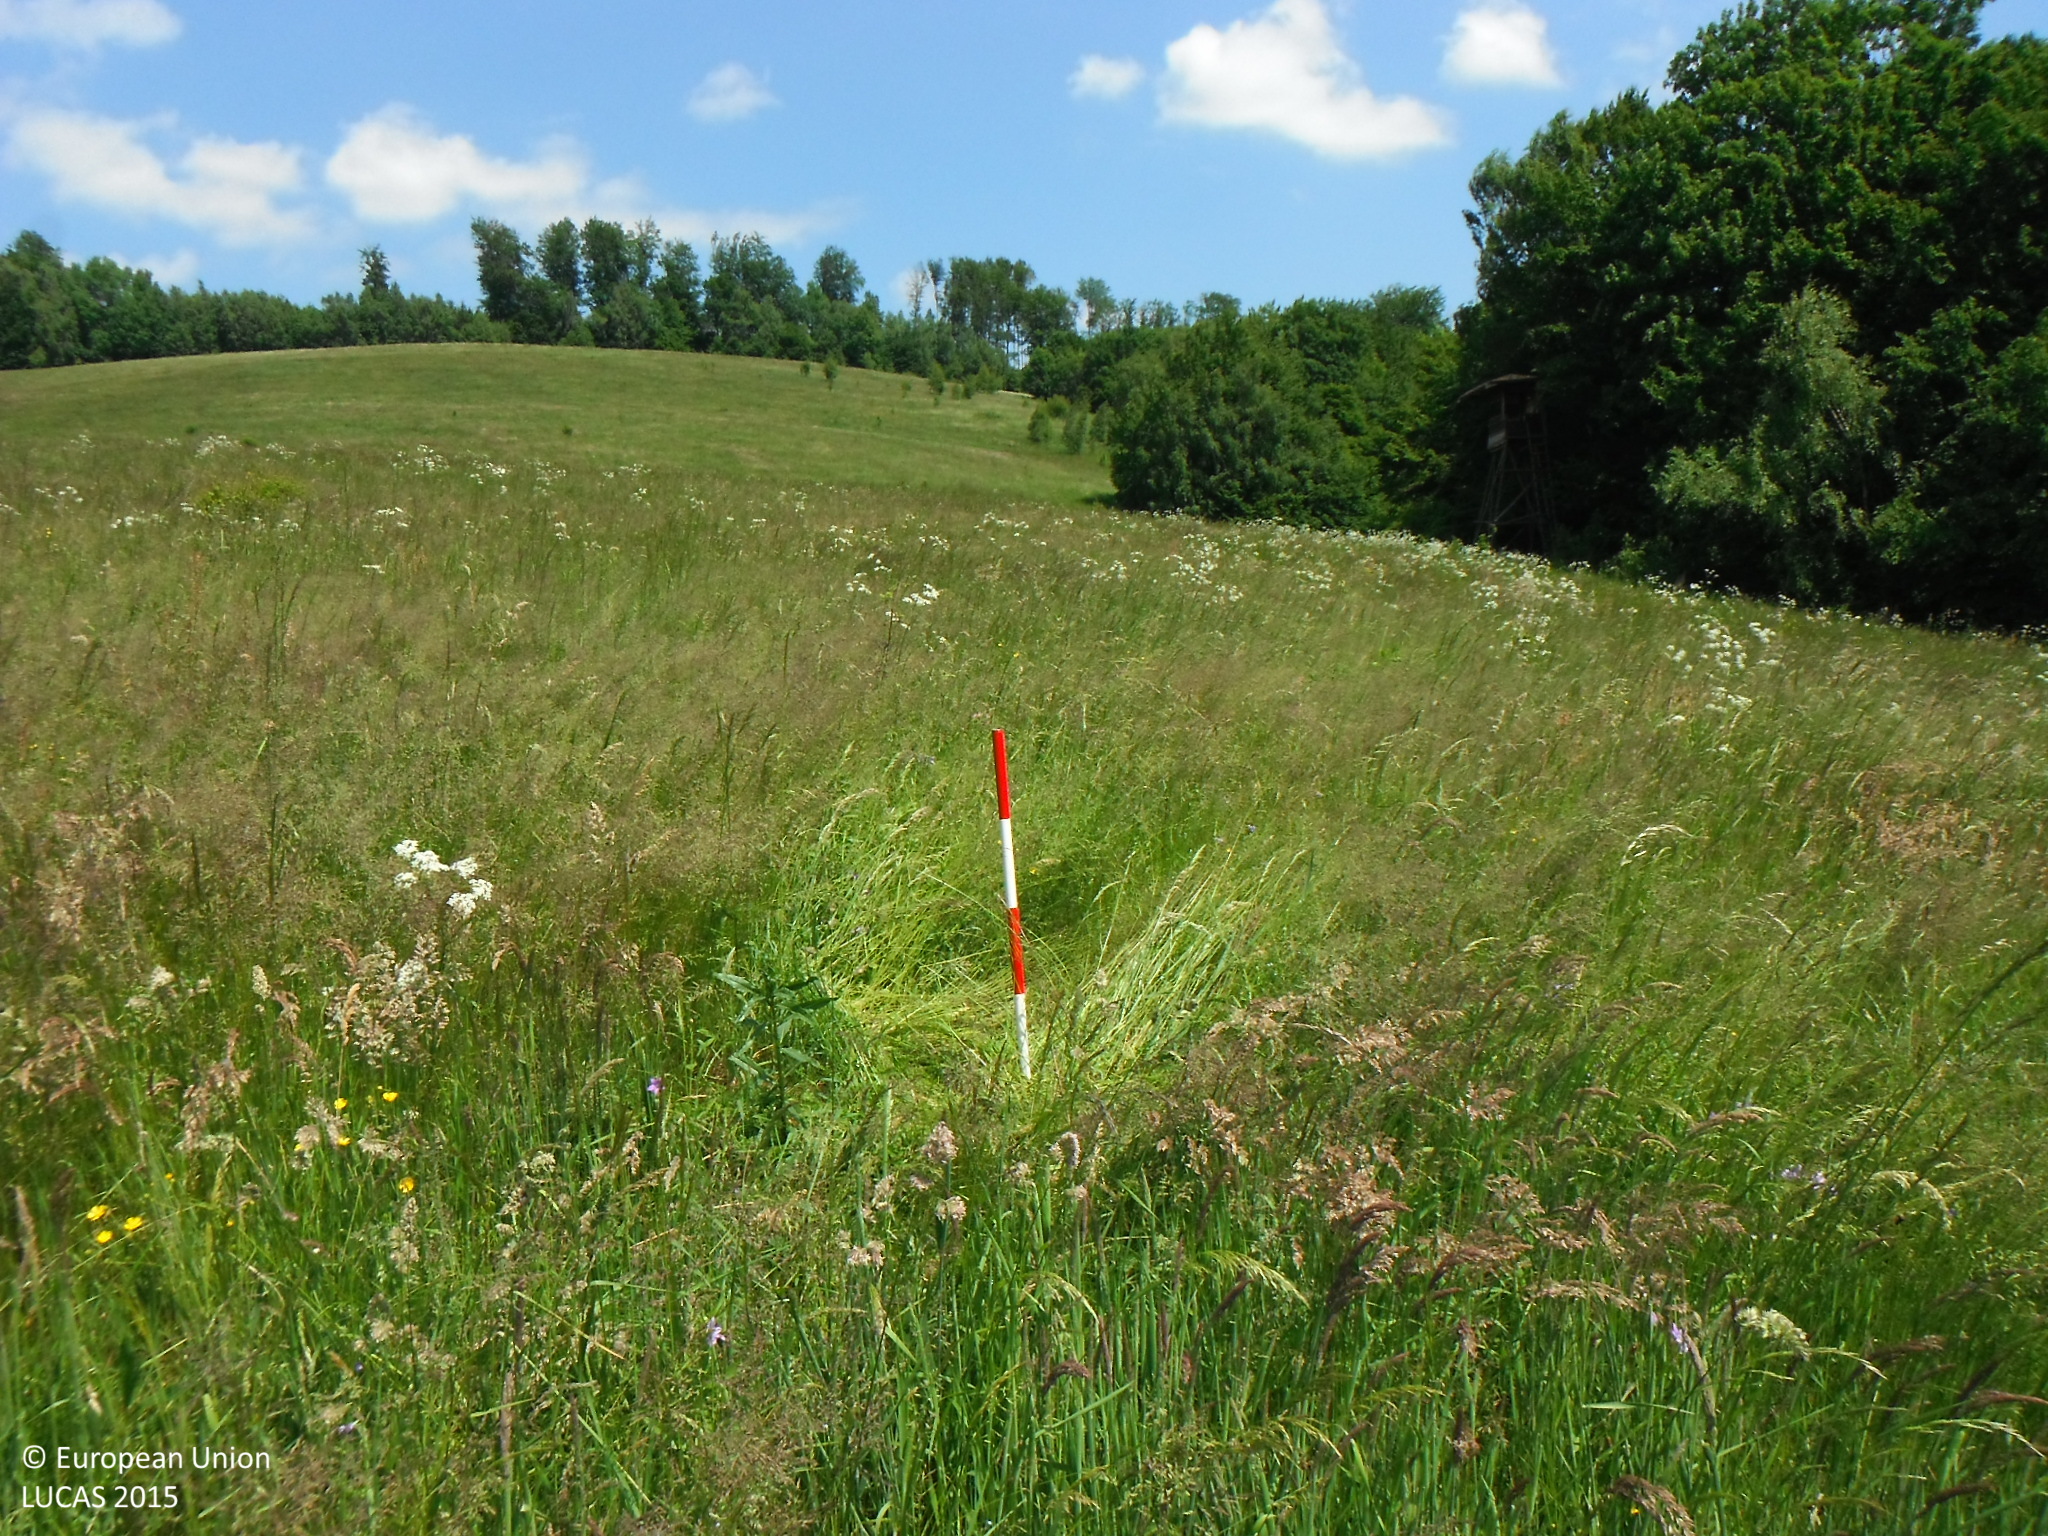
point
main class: Grassland
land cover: Grassland without tree/shrub cover
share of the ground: > 75 %
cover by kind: herbaceous plants 100 %
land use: Agriculture (excluding fallow land and kitchen gardens)
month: June
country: SK
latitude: 48.7835
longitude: 21.1351
